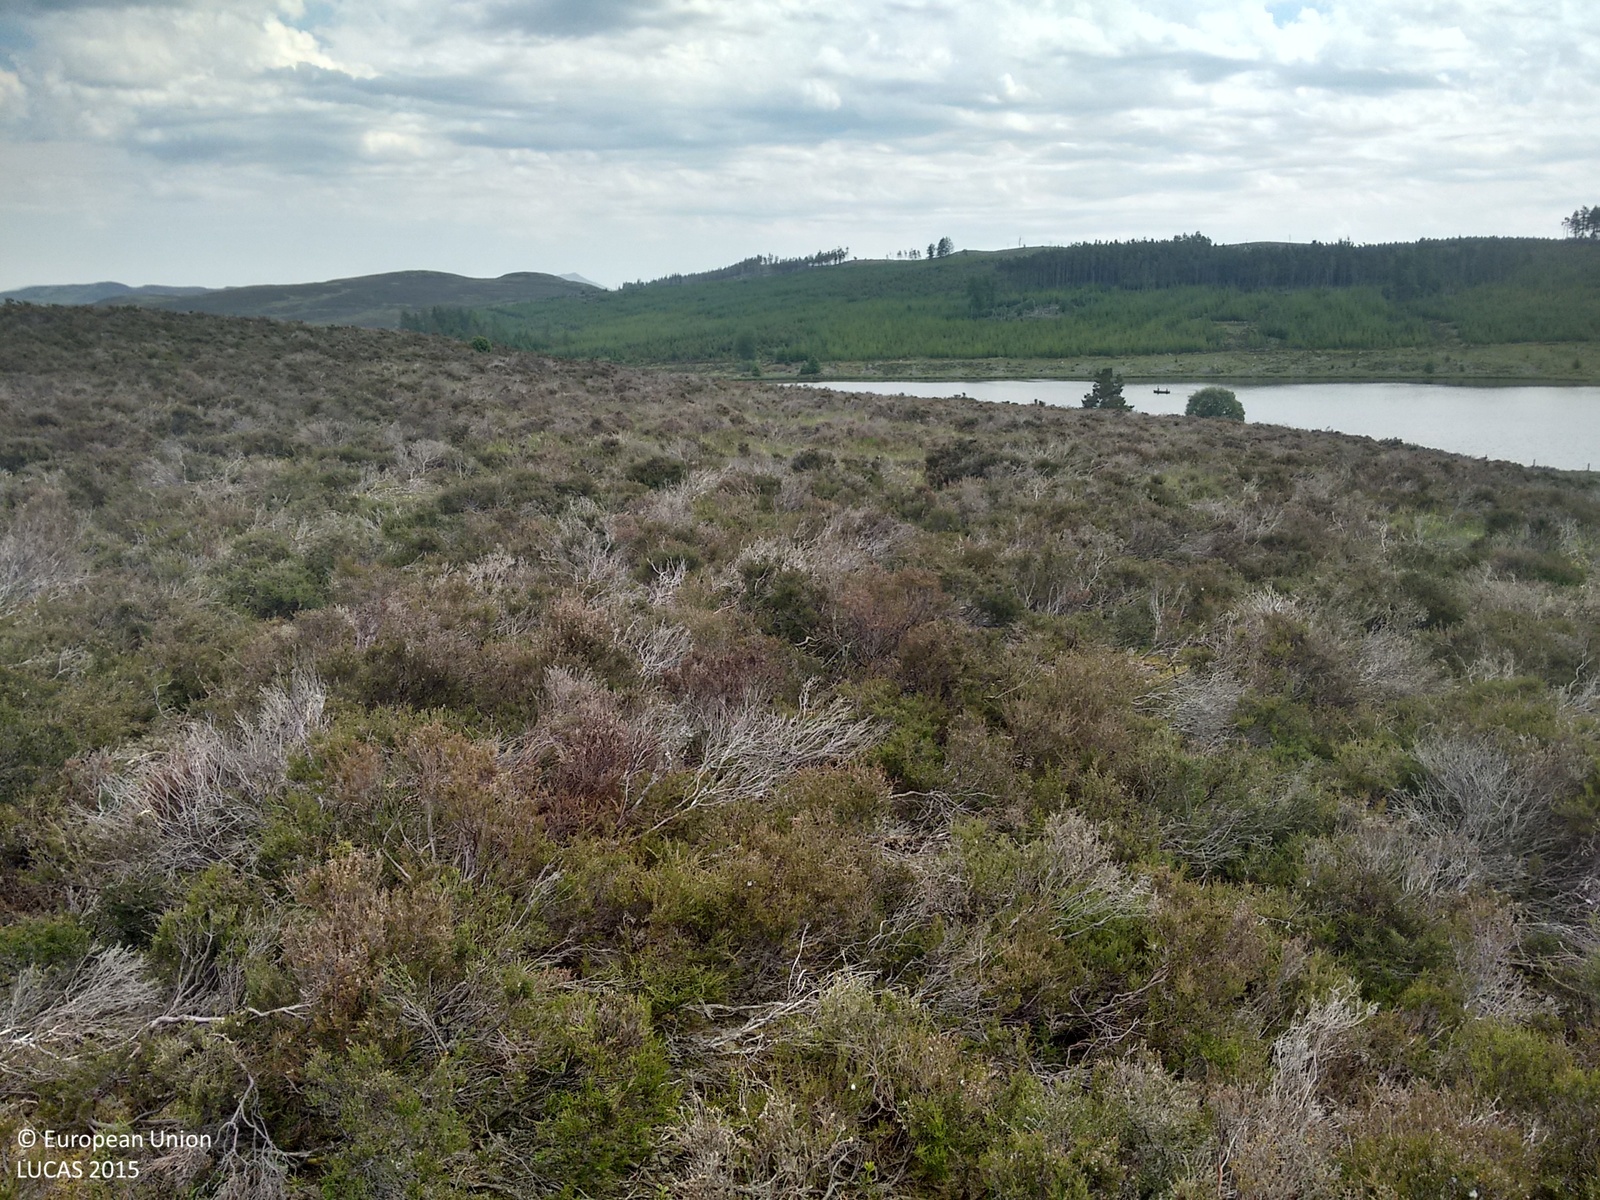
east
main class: Shrubland
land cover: Shrubland without tree cover
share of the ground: > 75 %
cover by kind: shrubs 95 %, herbaceous plants 5 %
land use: Semi-natural and natural areas not in use
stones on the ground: < 10 %
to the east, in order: Shrubland without tree cover; Grassland without tree/shrub cover; Shrubland without tree cover
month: July
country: GB
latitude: 56.7391
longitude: -3.9297
